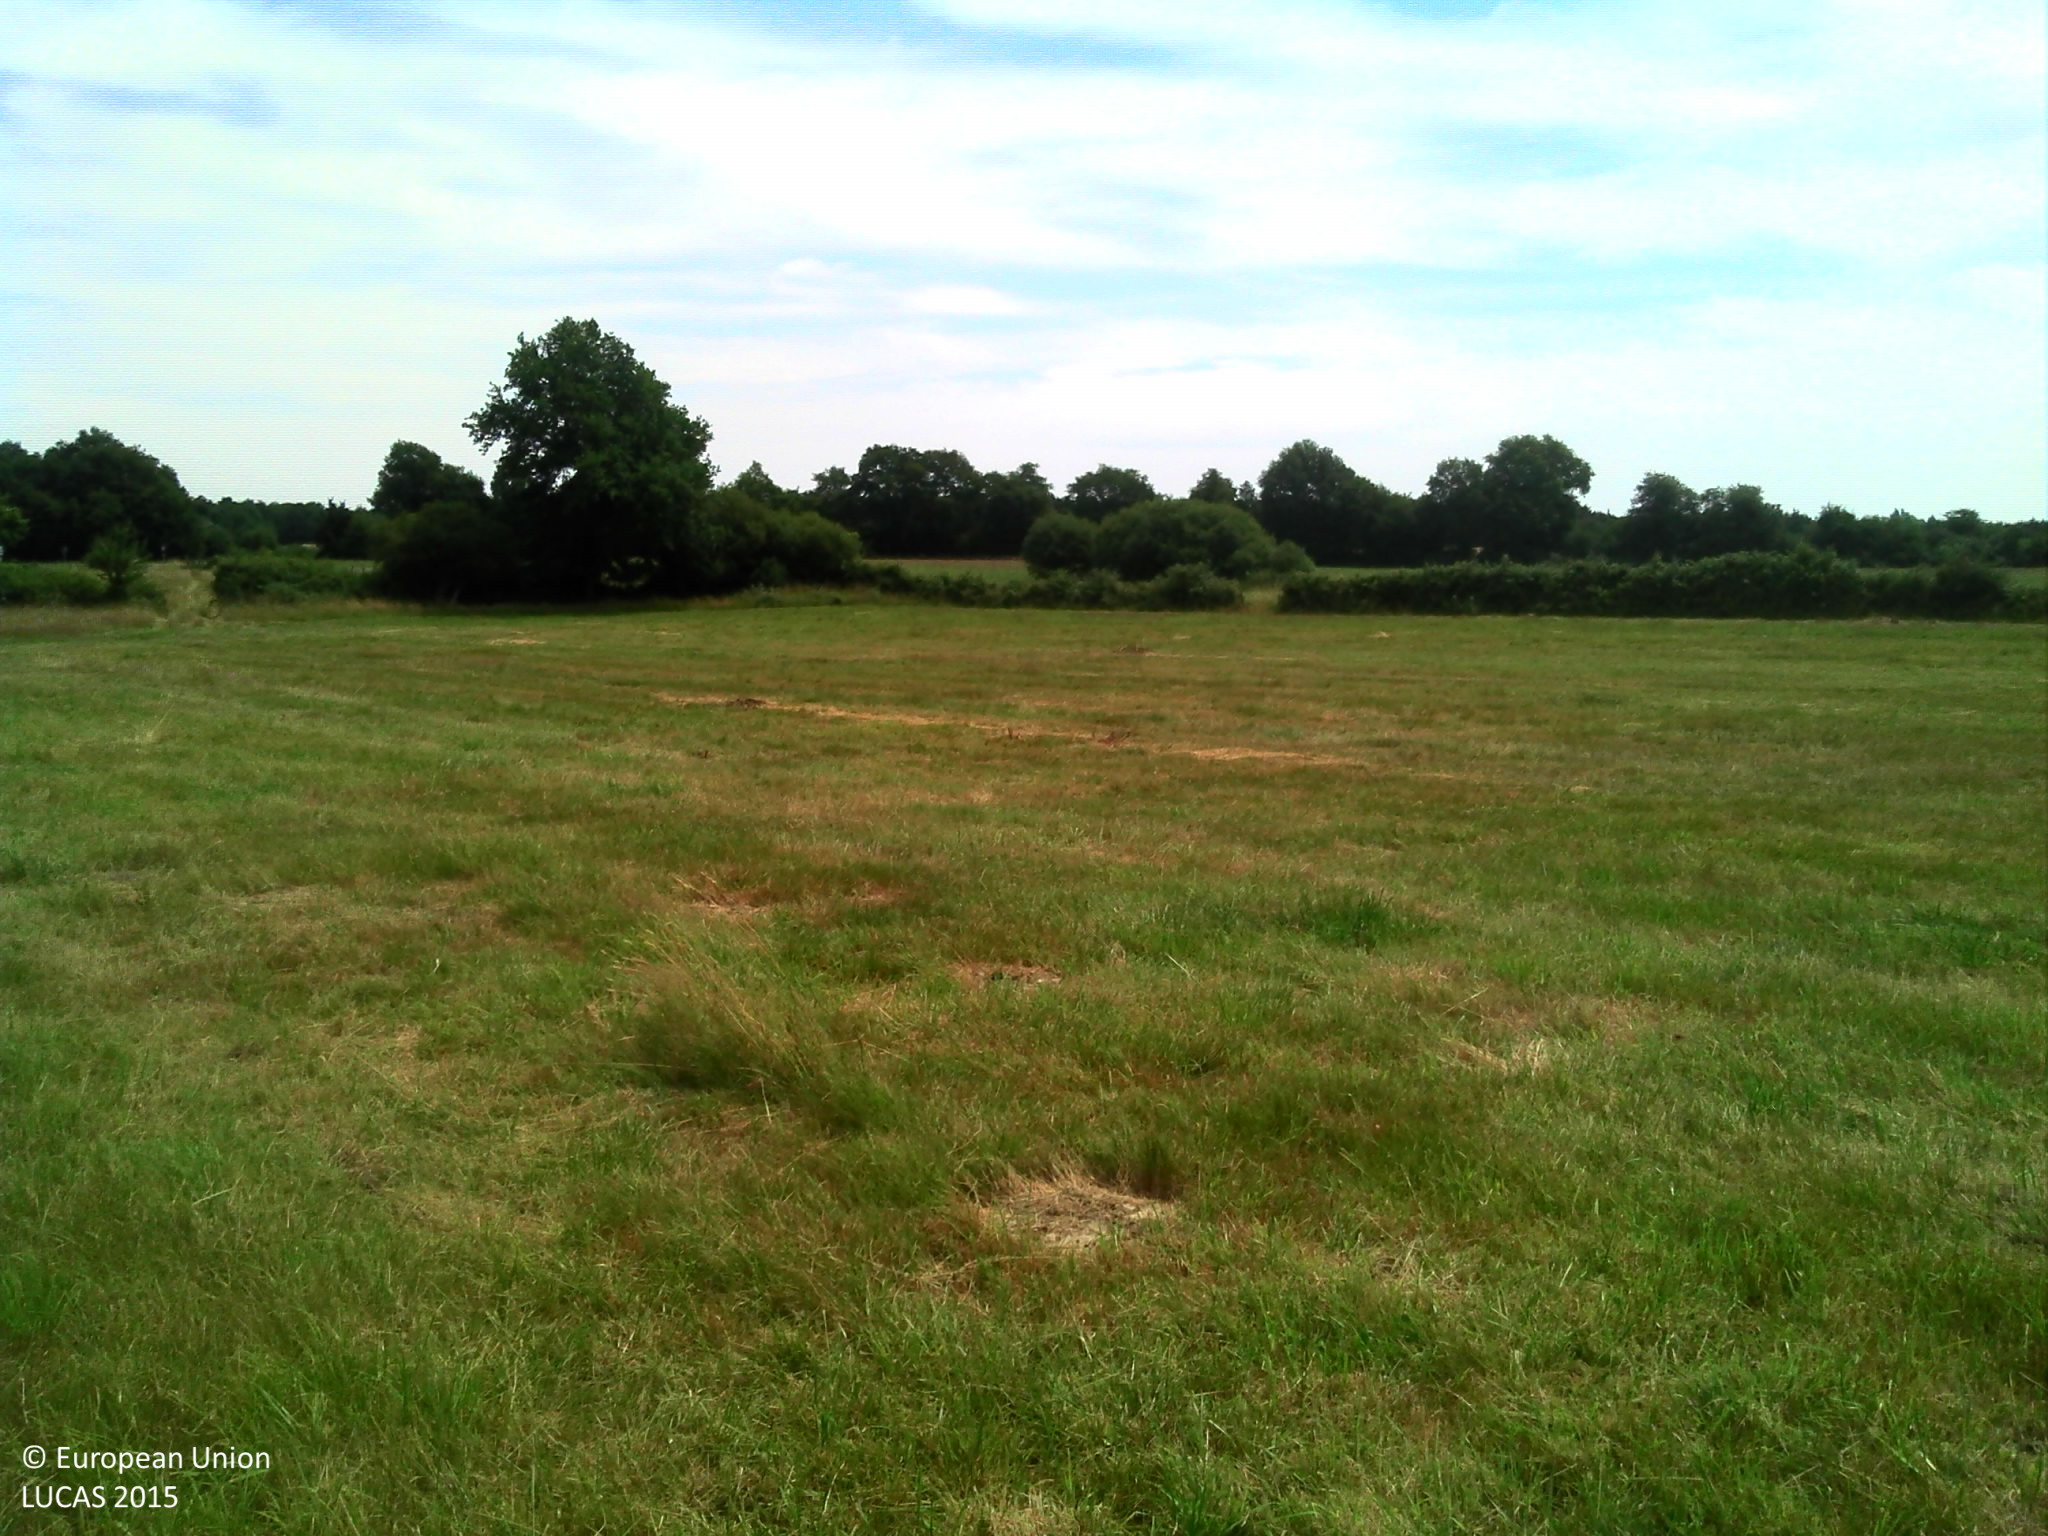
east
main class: Grassland
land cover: Grassland without tree/shrub cover
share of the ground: > 75 %
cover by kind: herbaceous plants 100 %
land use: Agriculture (excluding fallow land and kitchen gardens)
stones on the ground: < 10 %
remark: Harvested field
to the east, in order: Grassland without tree/shrub cover; Fences; Abandoned hedges; Grass margins; Ditches and canals; Grass margins; Paved roads, cycling and walking lanes; Grass margins; Ditches and canals; Grassland without tree/shrub cover; Abandoned hedges; Grassland without tree/shrub cover; Other bare soil
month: June
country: FR
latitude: 47.5225
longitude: 0.2949
